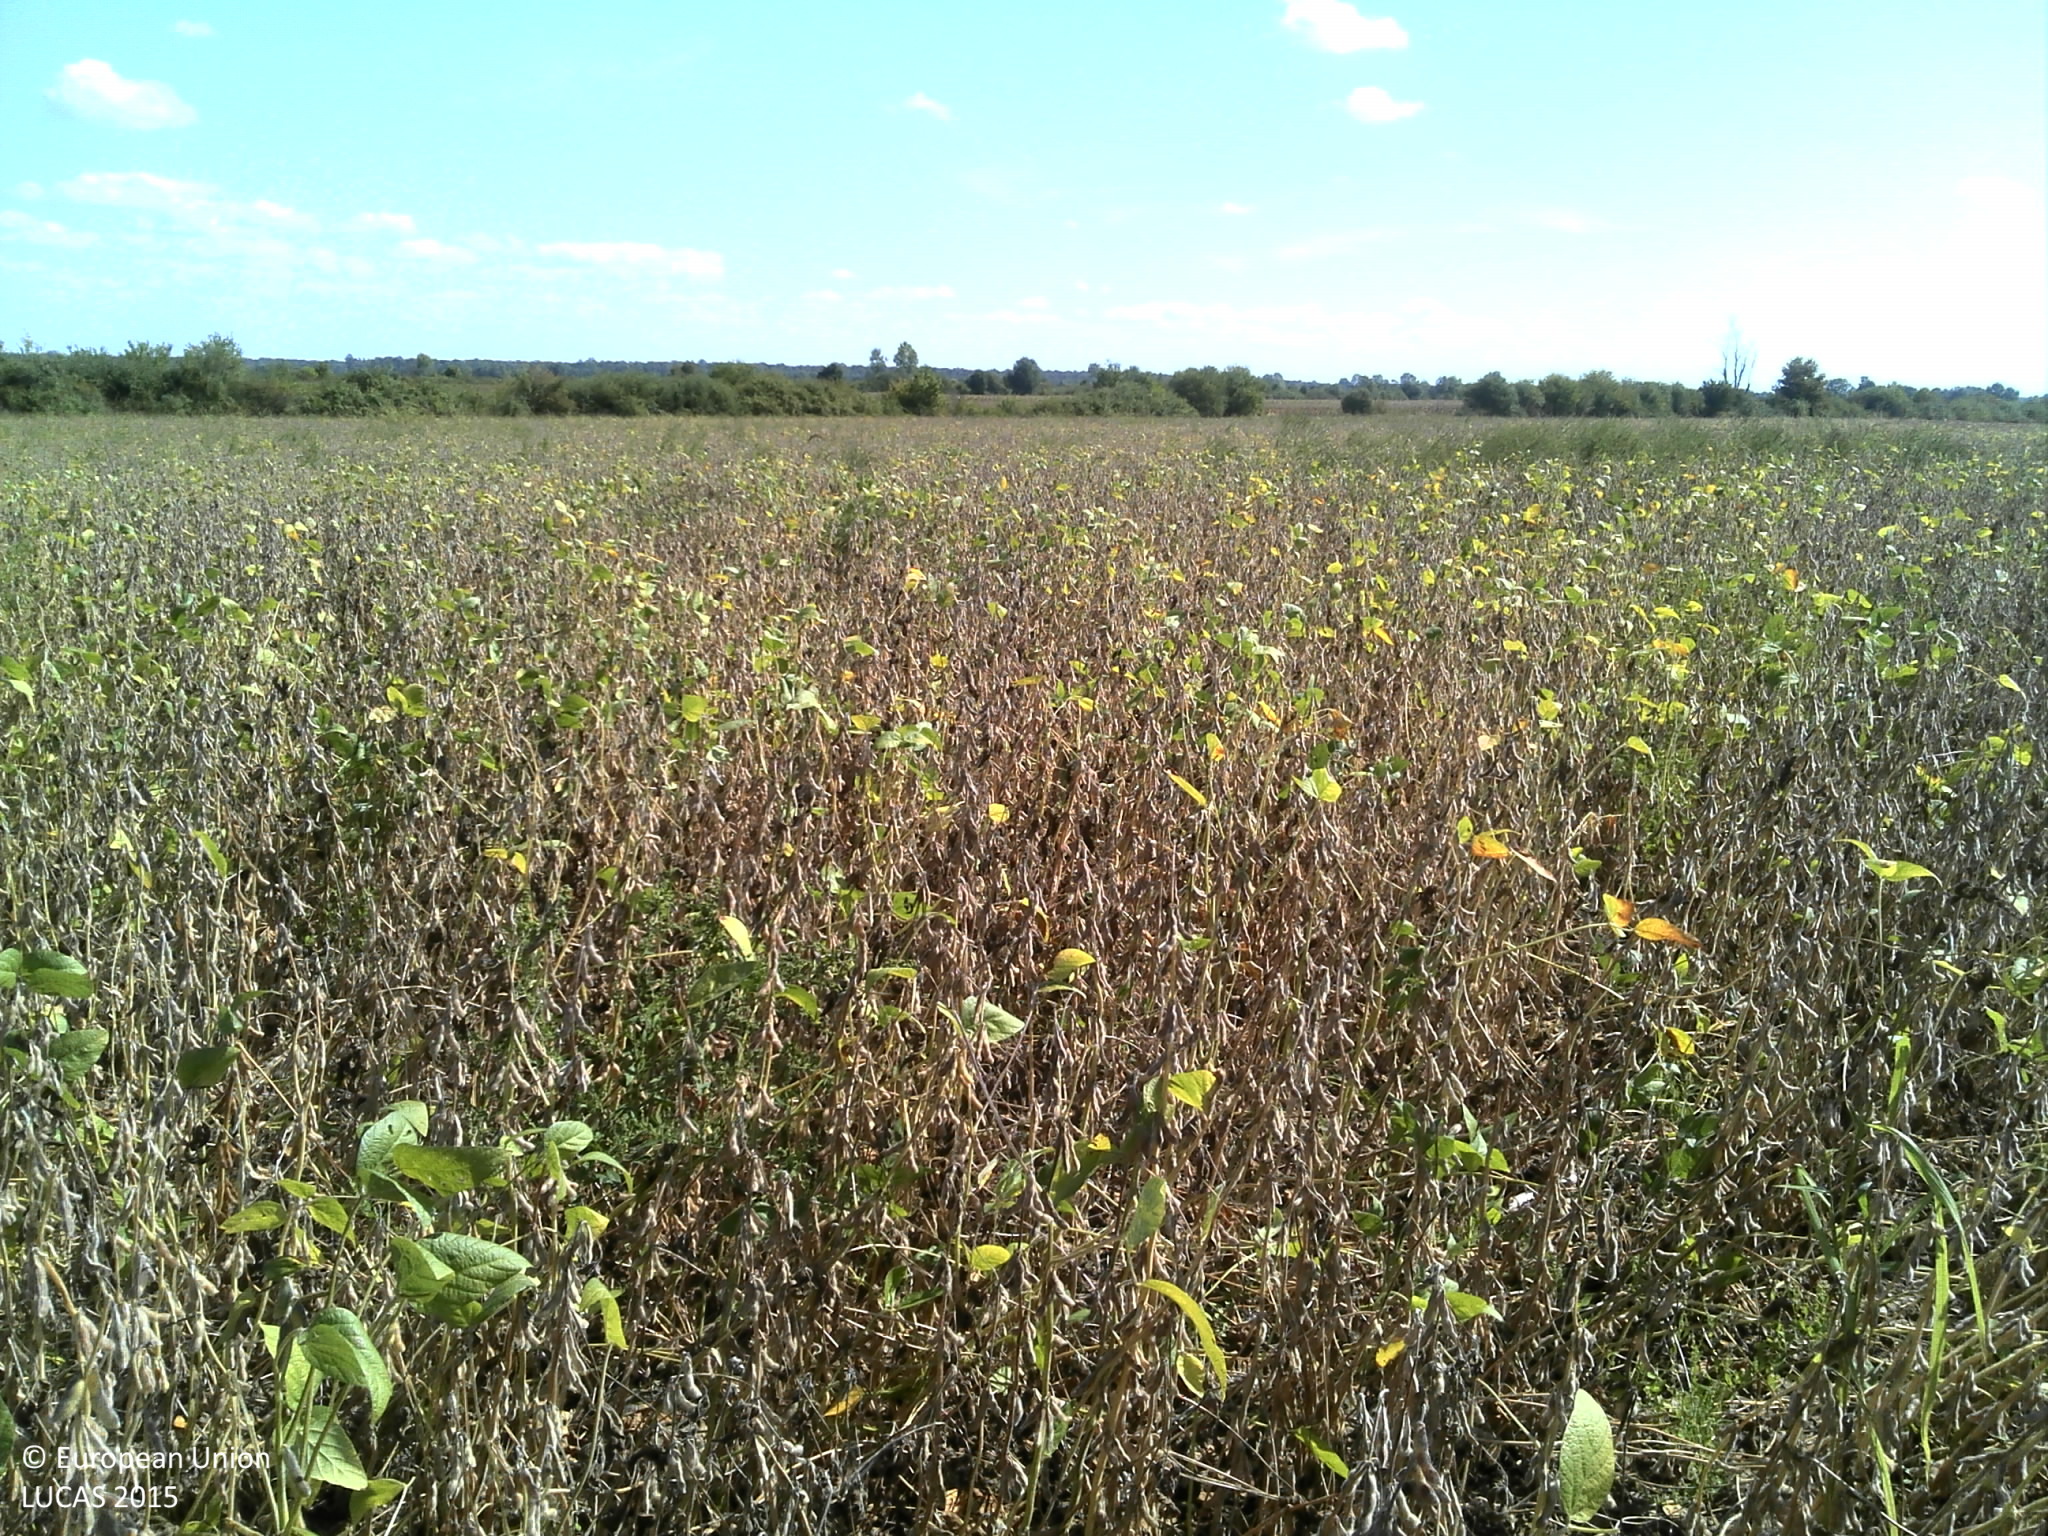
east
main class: Cropland
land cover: Soya
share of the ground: > 75 %
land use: Agriculture (excluding fallow land and kitchen gardens)
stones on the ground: < 10 %
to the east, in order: Soya; Shrubland with sparse tree cover; Ditches and canals; Grass margins; Maize
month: September
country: HR
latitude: 44.9367
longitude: 19.0166
